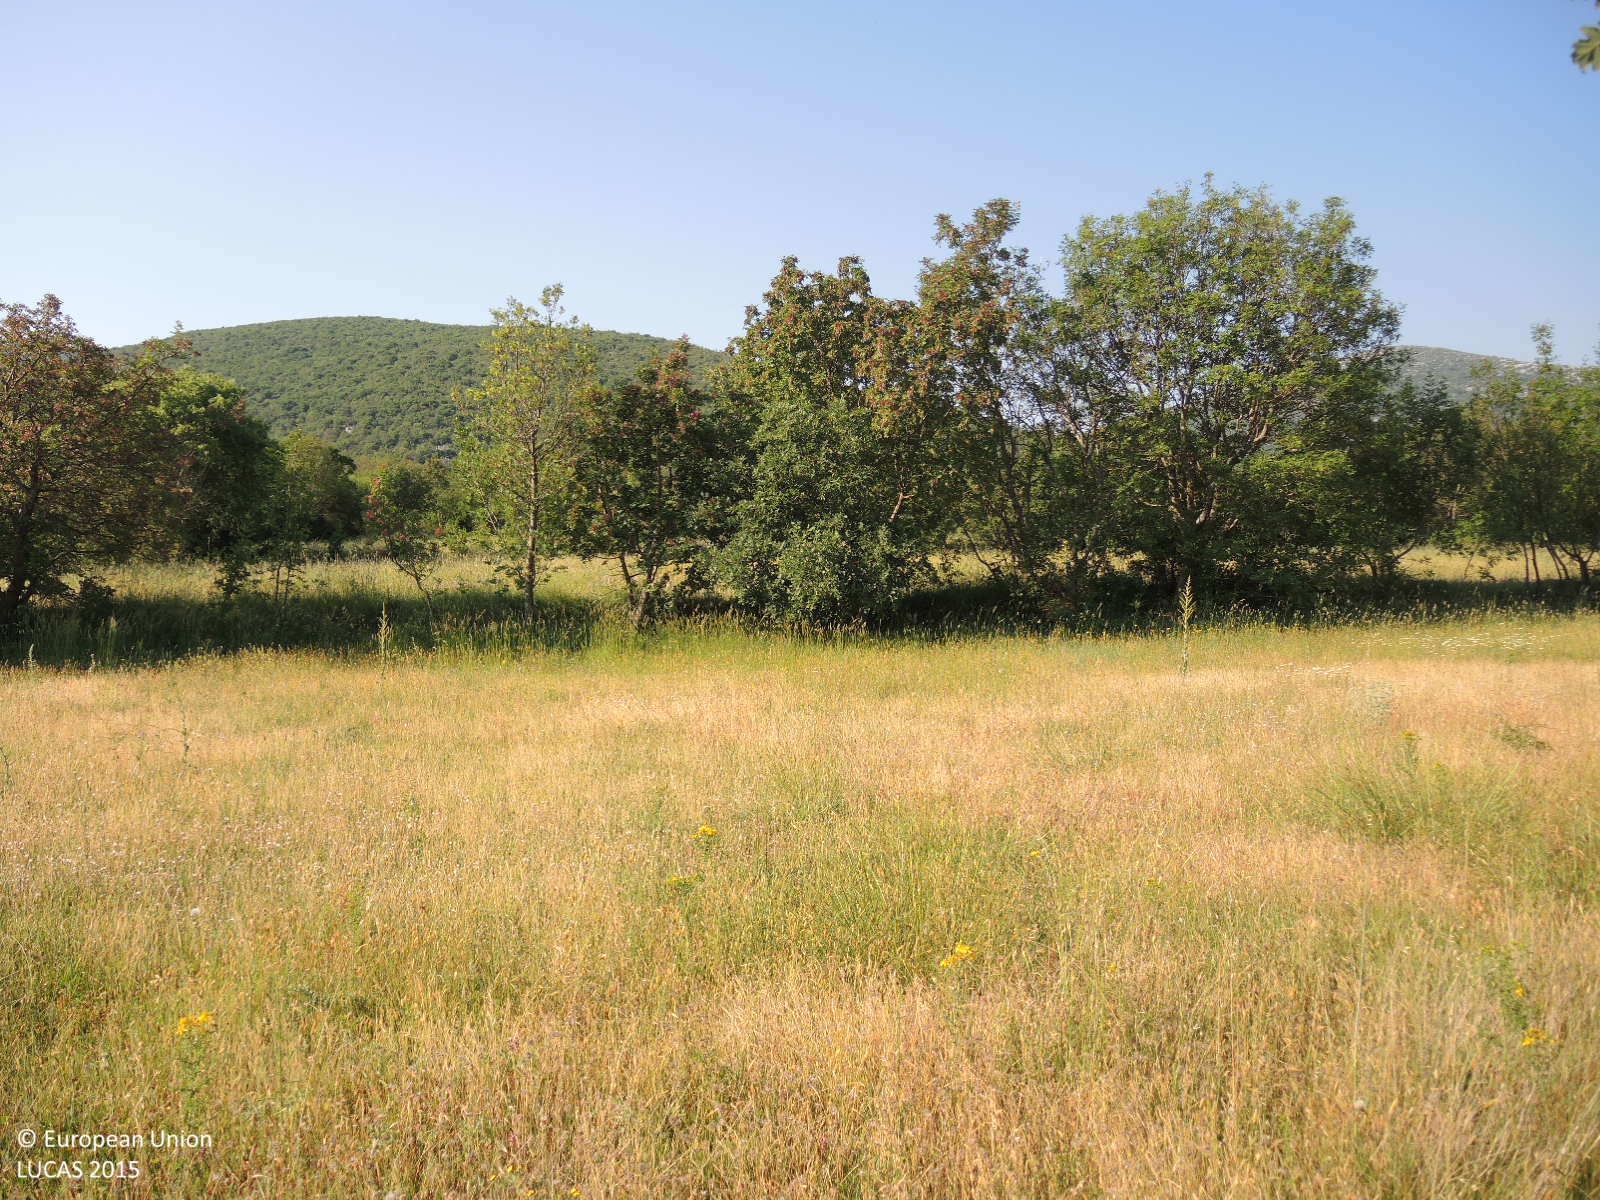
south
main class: Grassland
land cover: Grassland with sparse tree/shrub cover
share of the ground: 10 - 25 %
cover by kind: herbaceous plants 85 %, broadleaved forest trees 5 %, shrubs 5 %, unconsolidated bare surface 5 %
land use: Abandoned areas
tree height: < 5 m
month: June
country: HR
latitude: 43.6045
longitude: 16.1977
